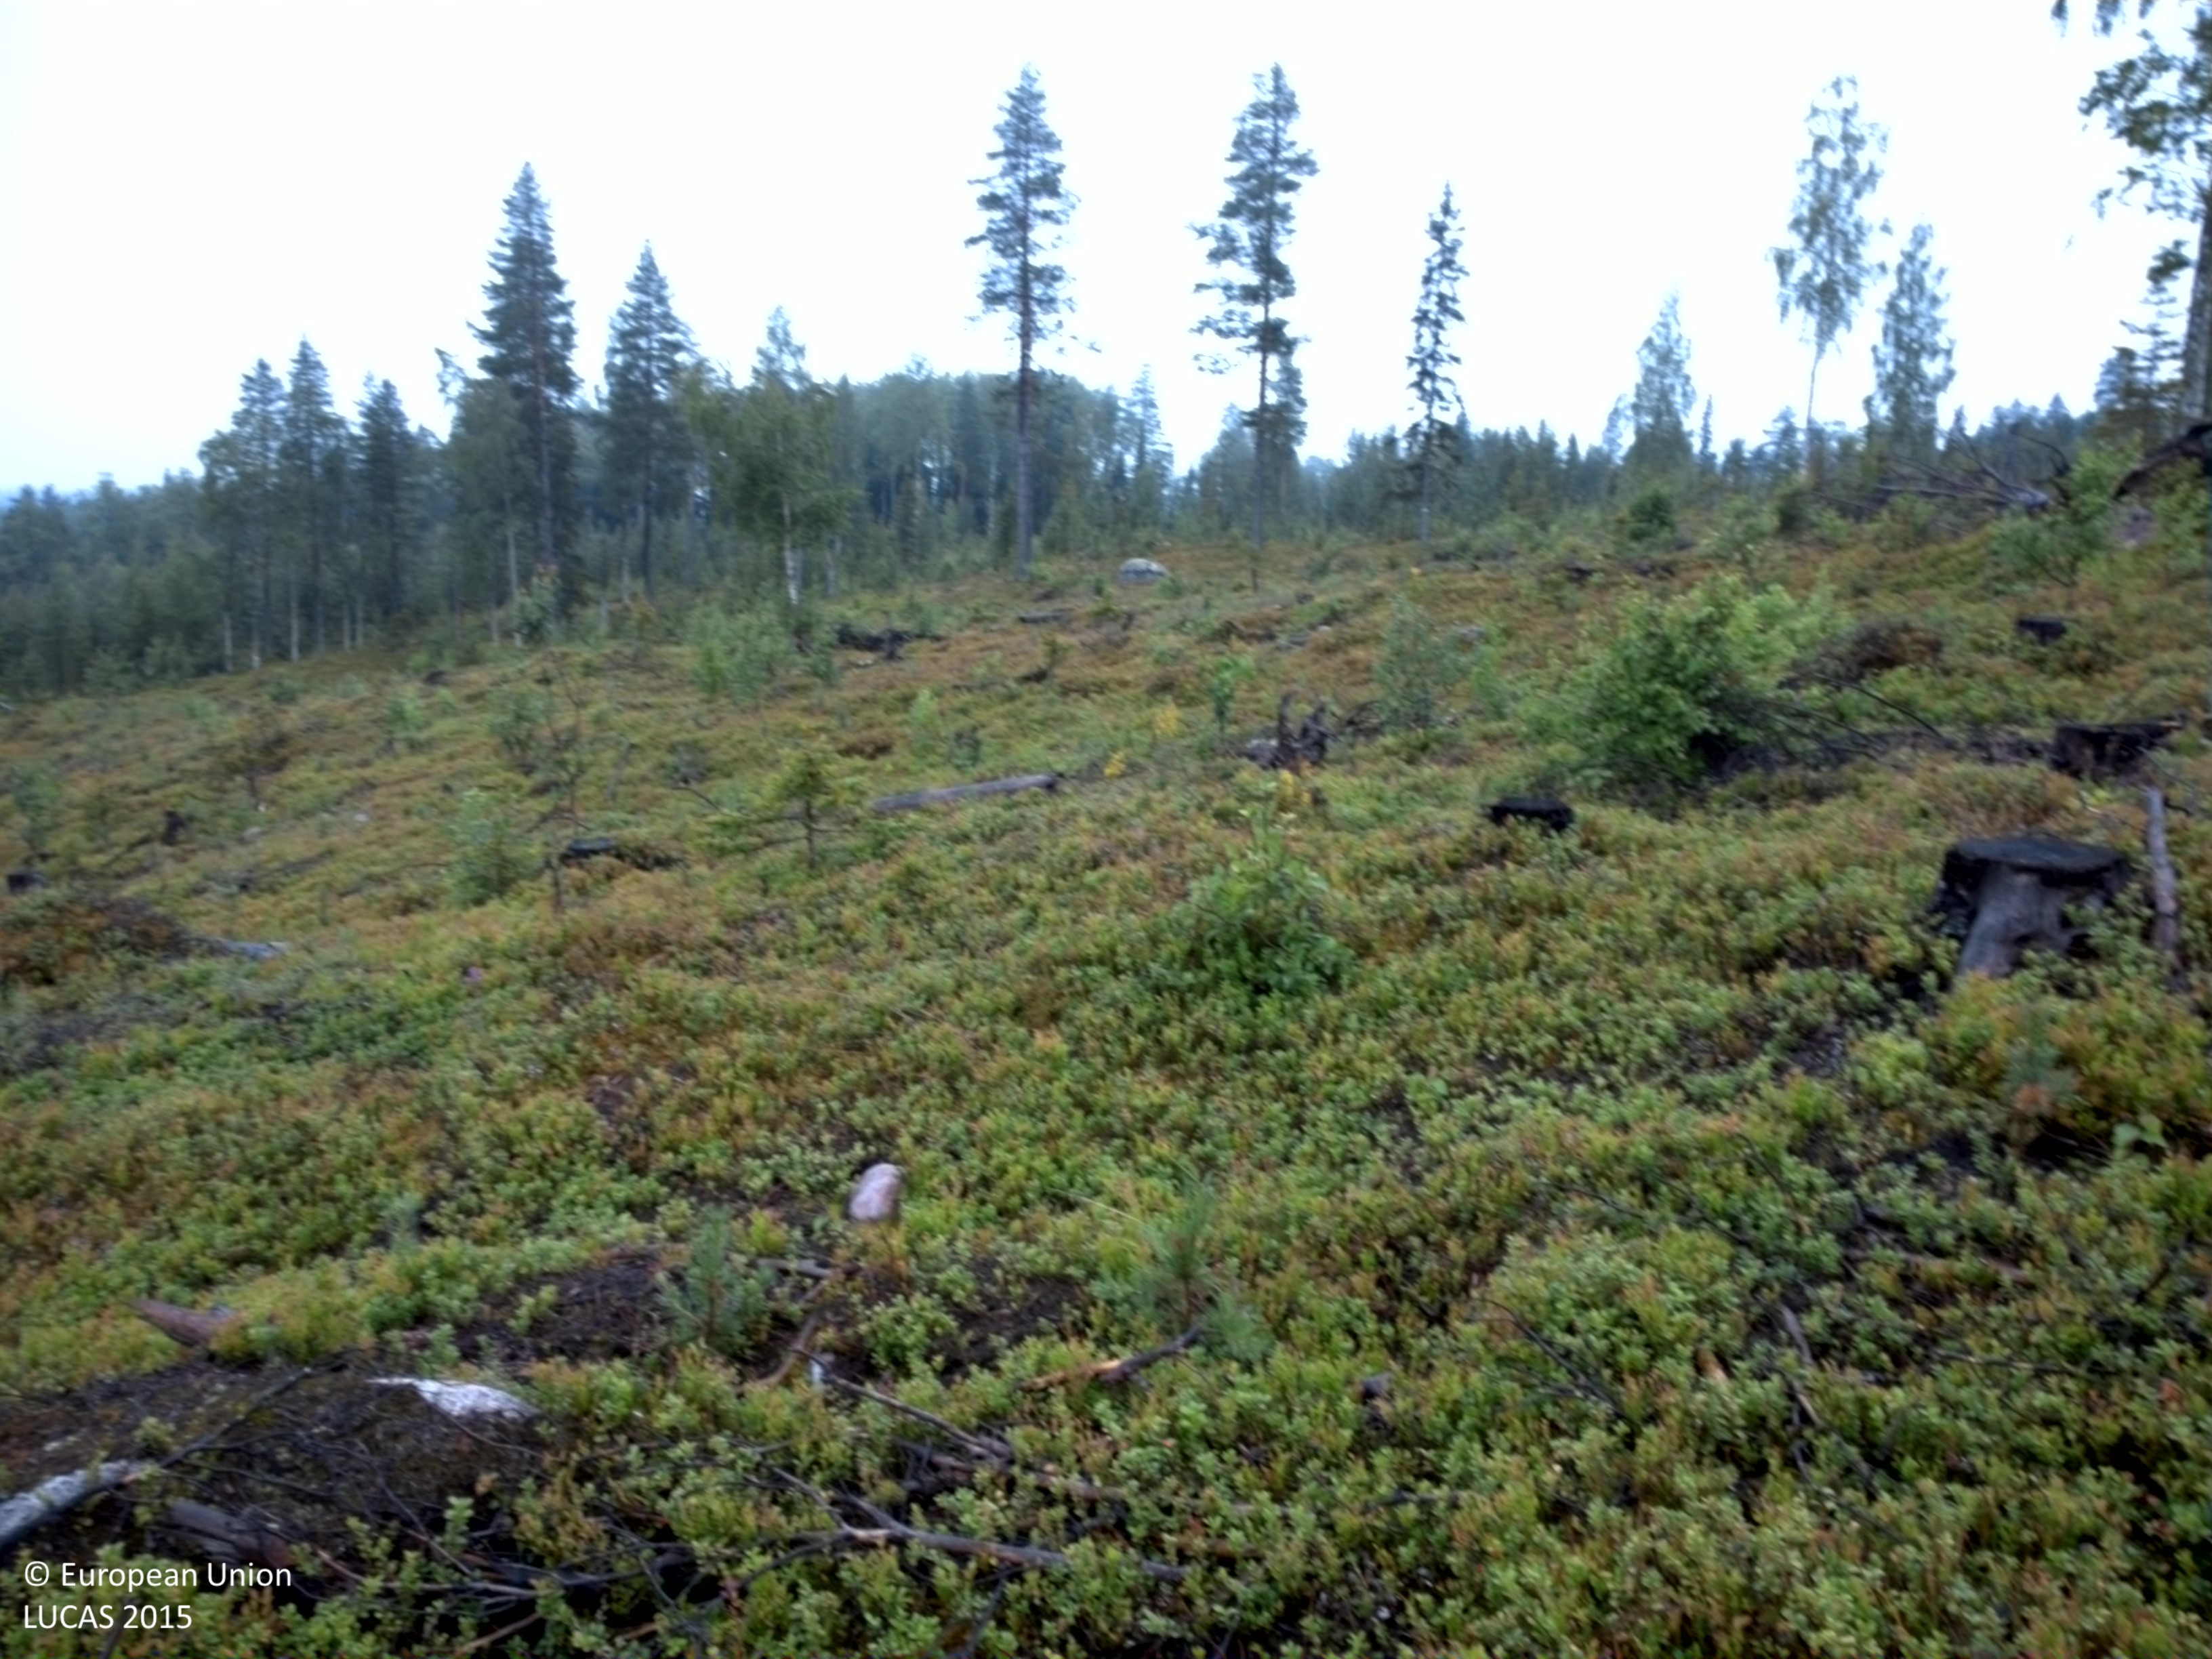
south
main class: Shrubland
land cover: Shrubland with sparse tree cover
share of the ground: > 75 %
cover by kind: shrubs 90 %, coniferous forest trees 5 %, unconsolidated bare surface 5 %
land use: Forestry
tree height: < 5 m
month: August
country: SE
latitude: 66.3494
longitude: 20.5245
